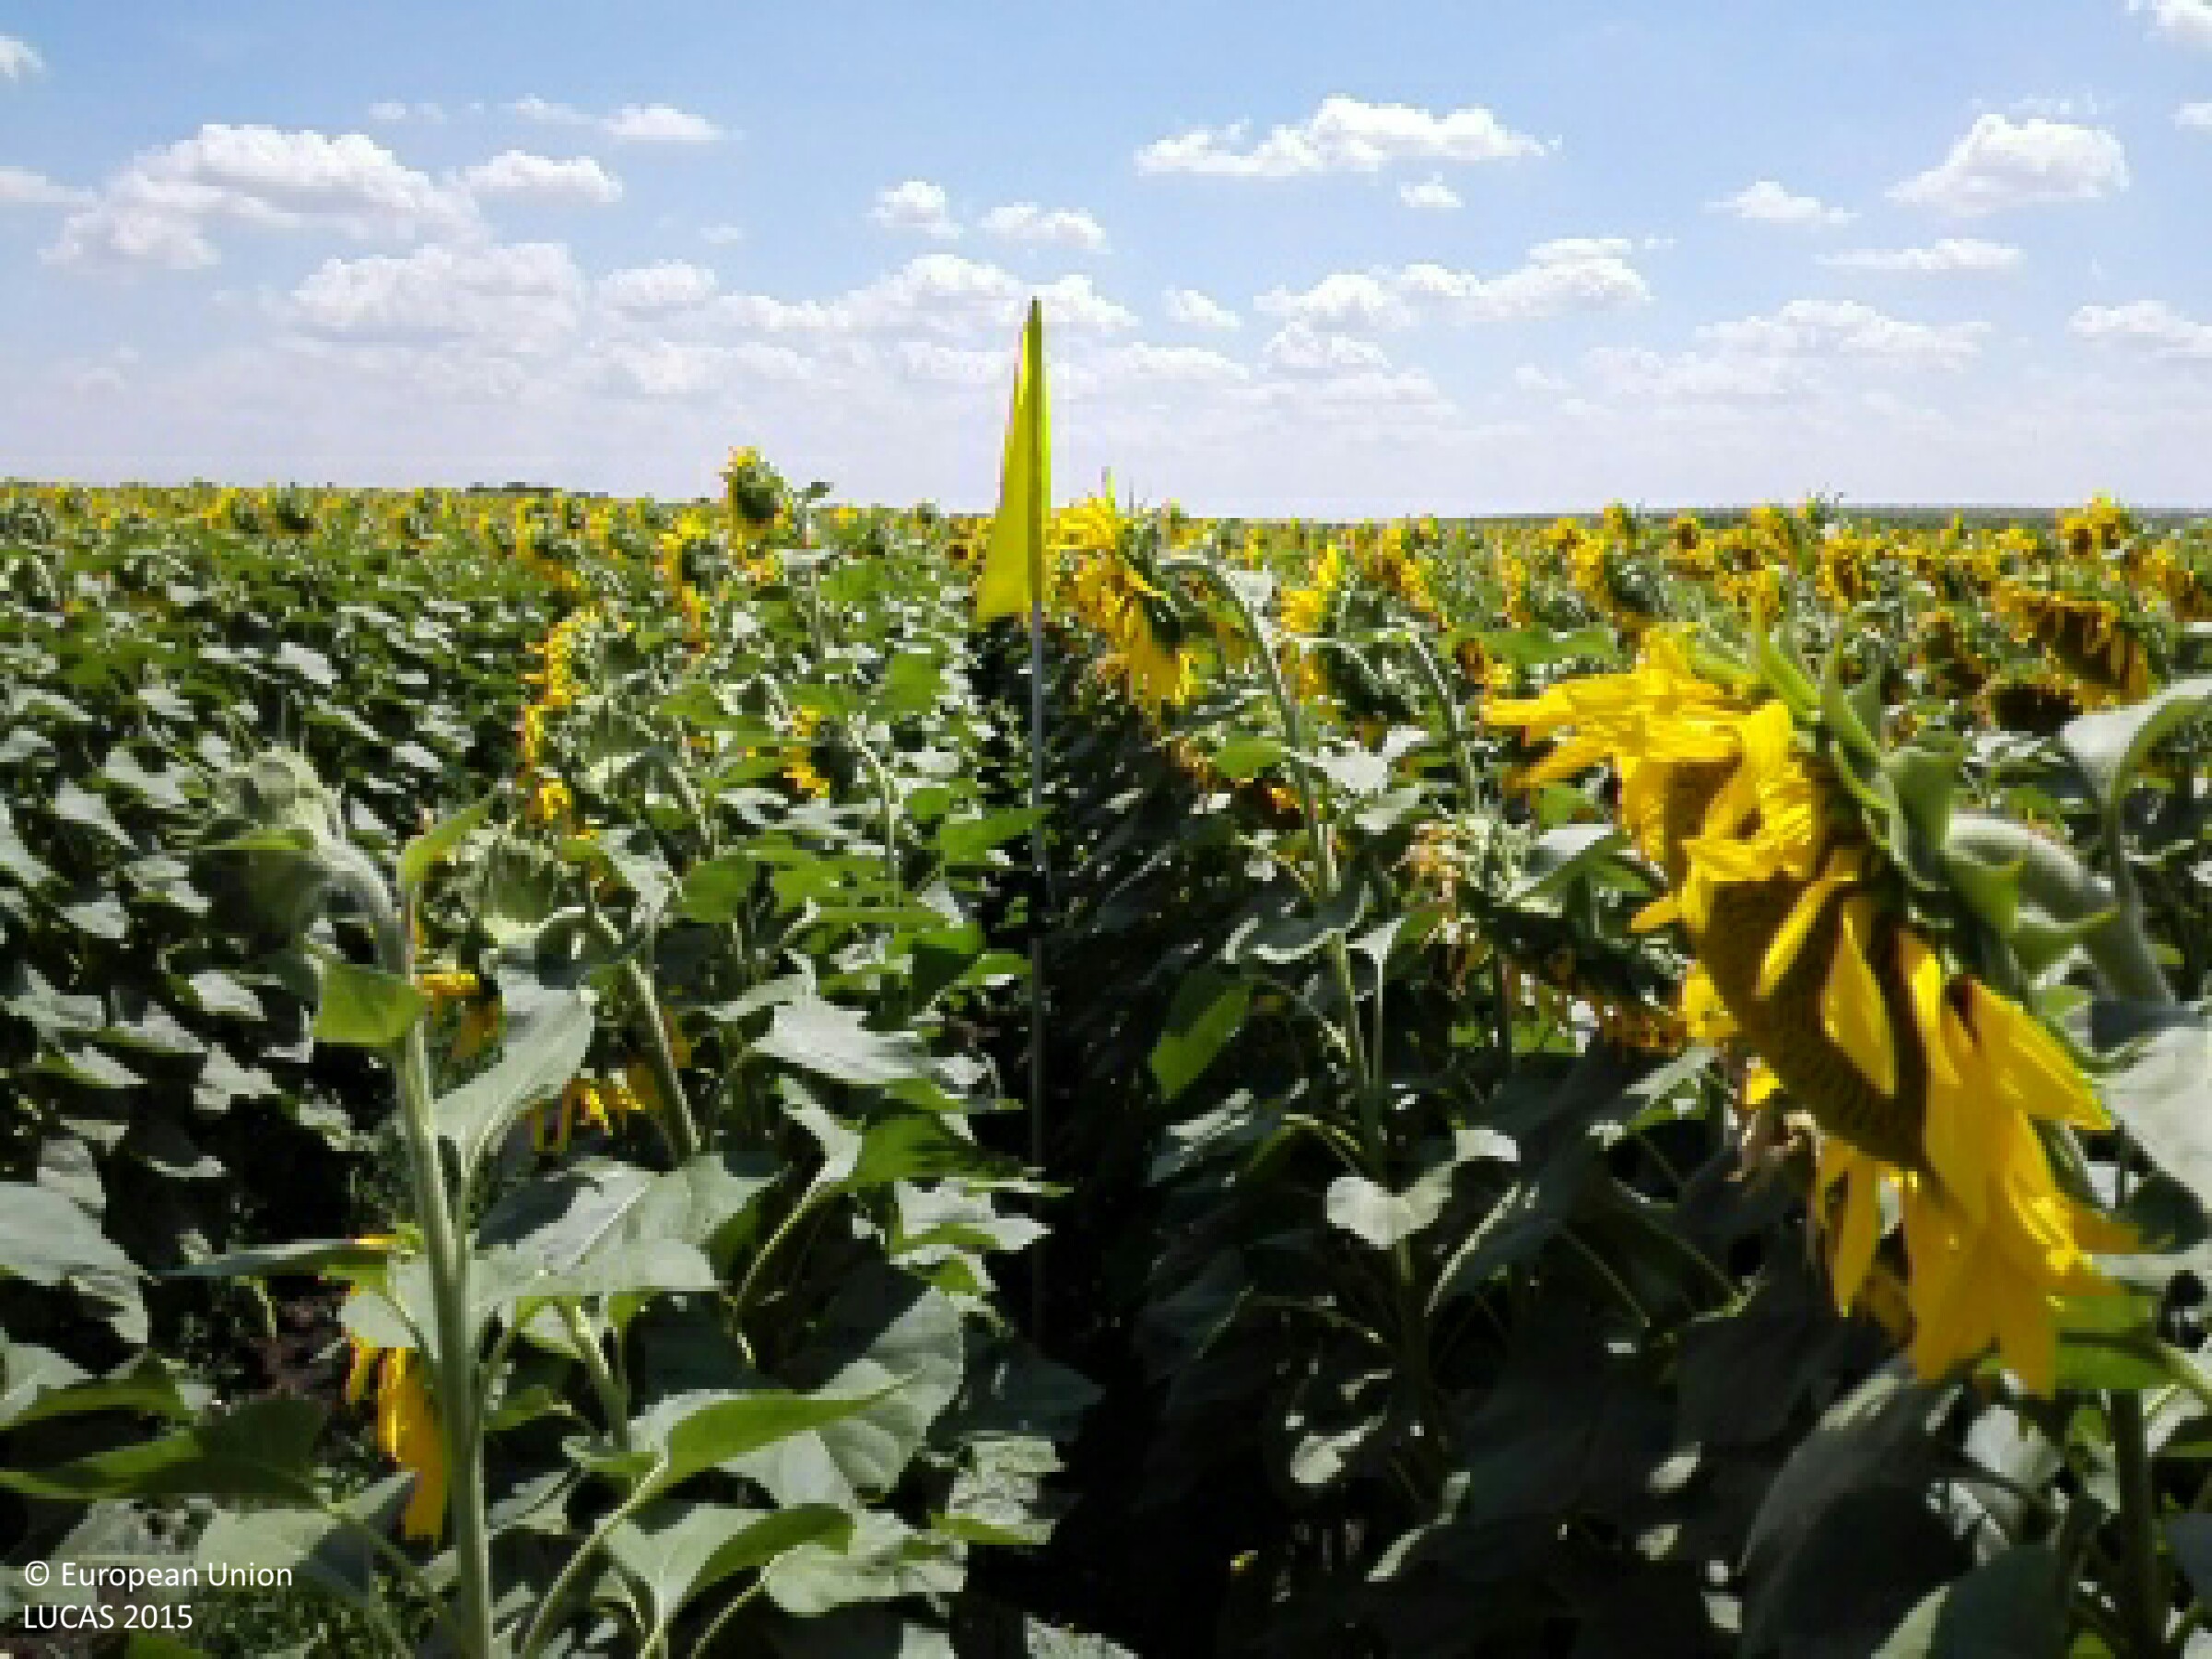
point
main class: Cropland
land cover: Sunflower
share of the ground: > 75 %
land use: Agriculture (excluding fallow land and kitchen gardens)
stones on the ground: < 10 %
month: July
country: HU
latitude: 47.4203
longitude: 21.3204
